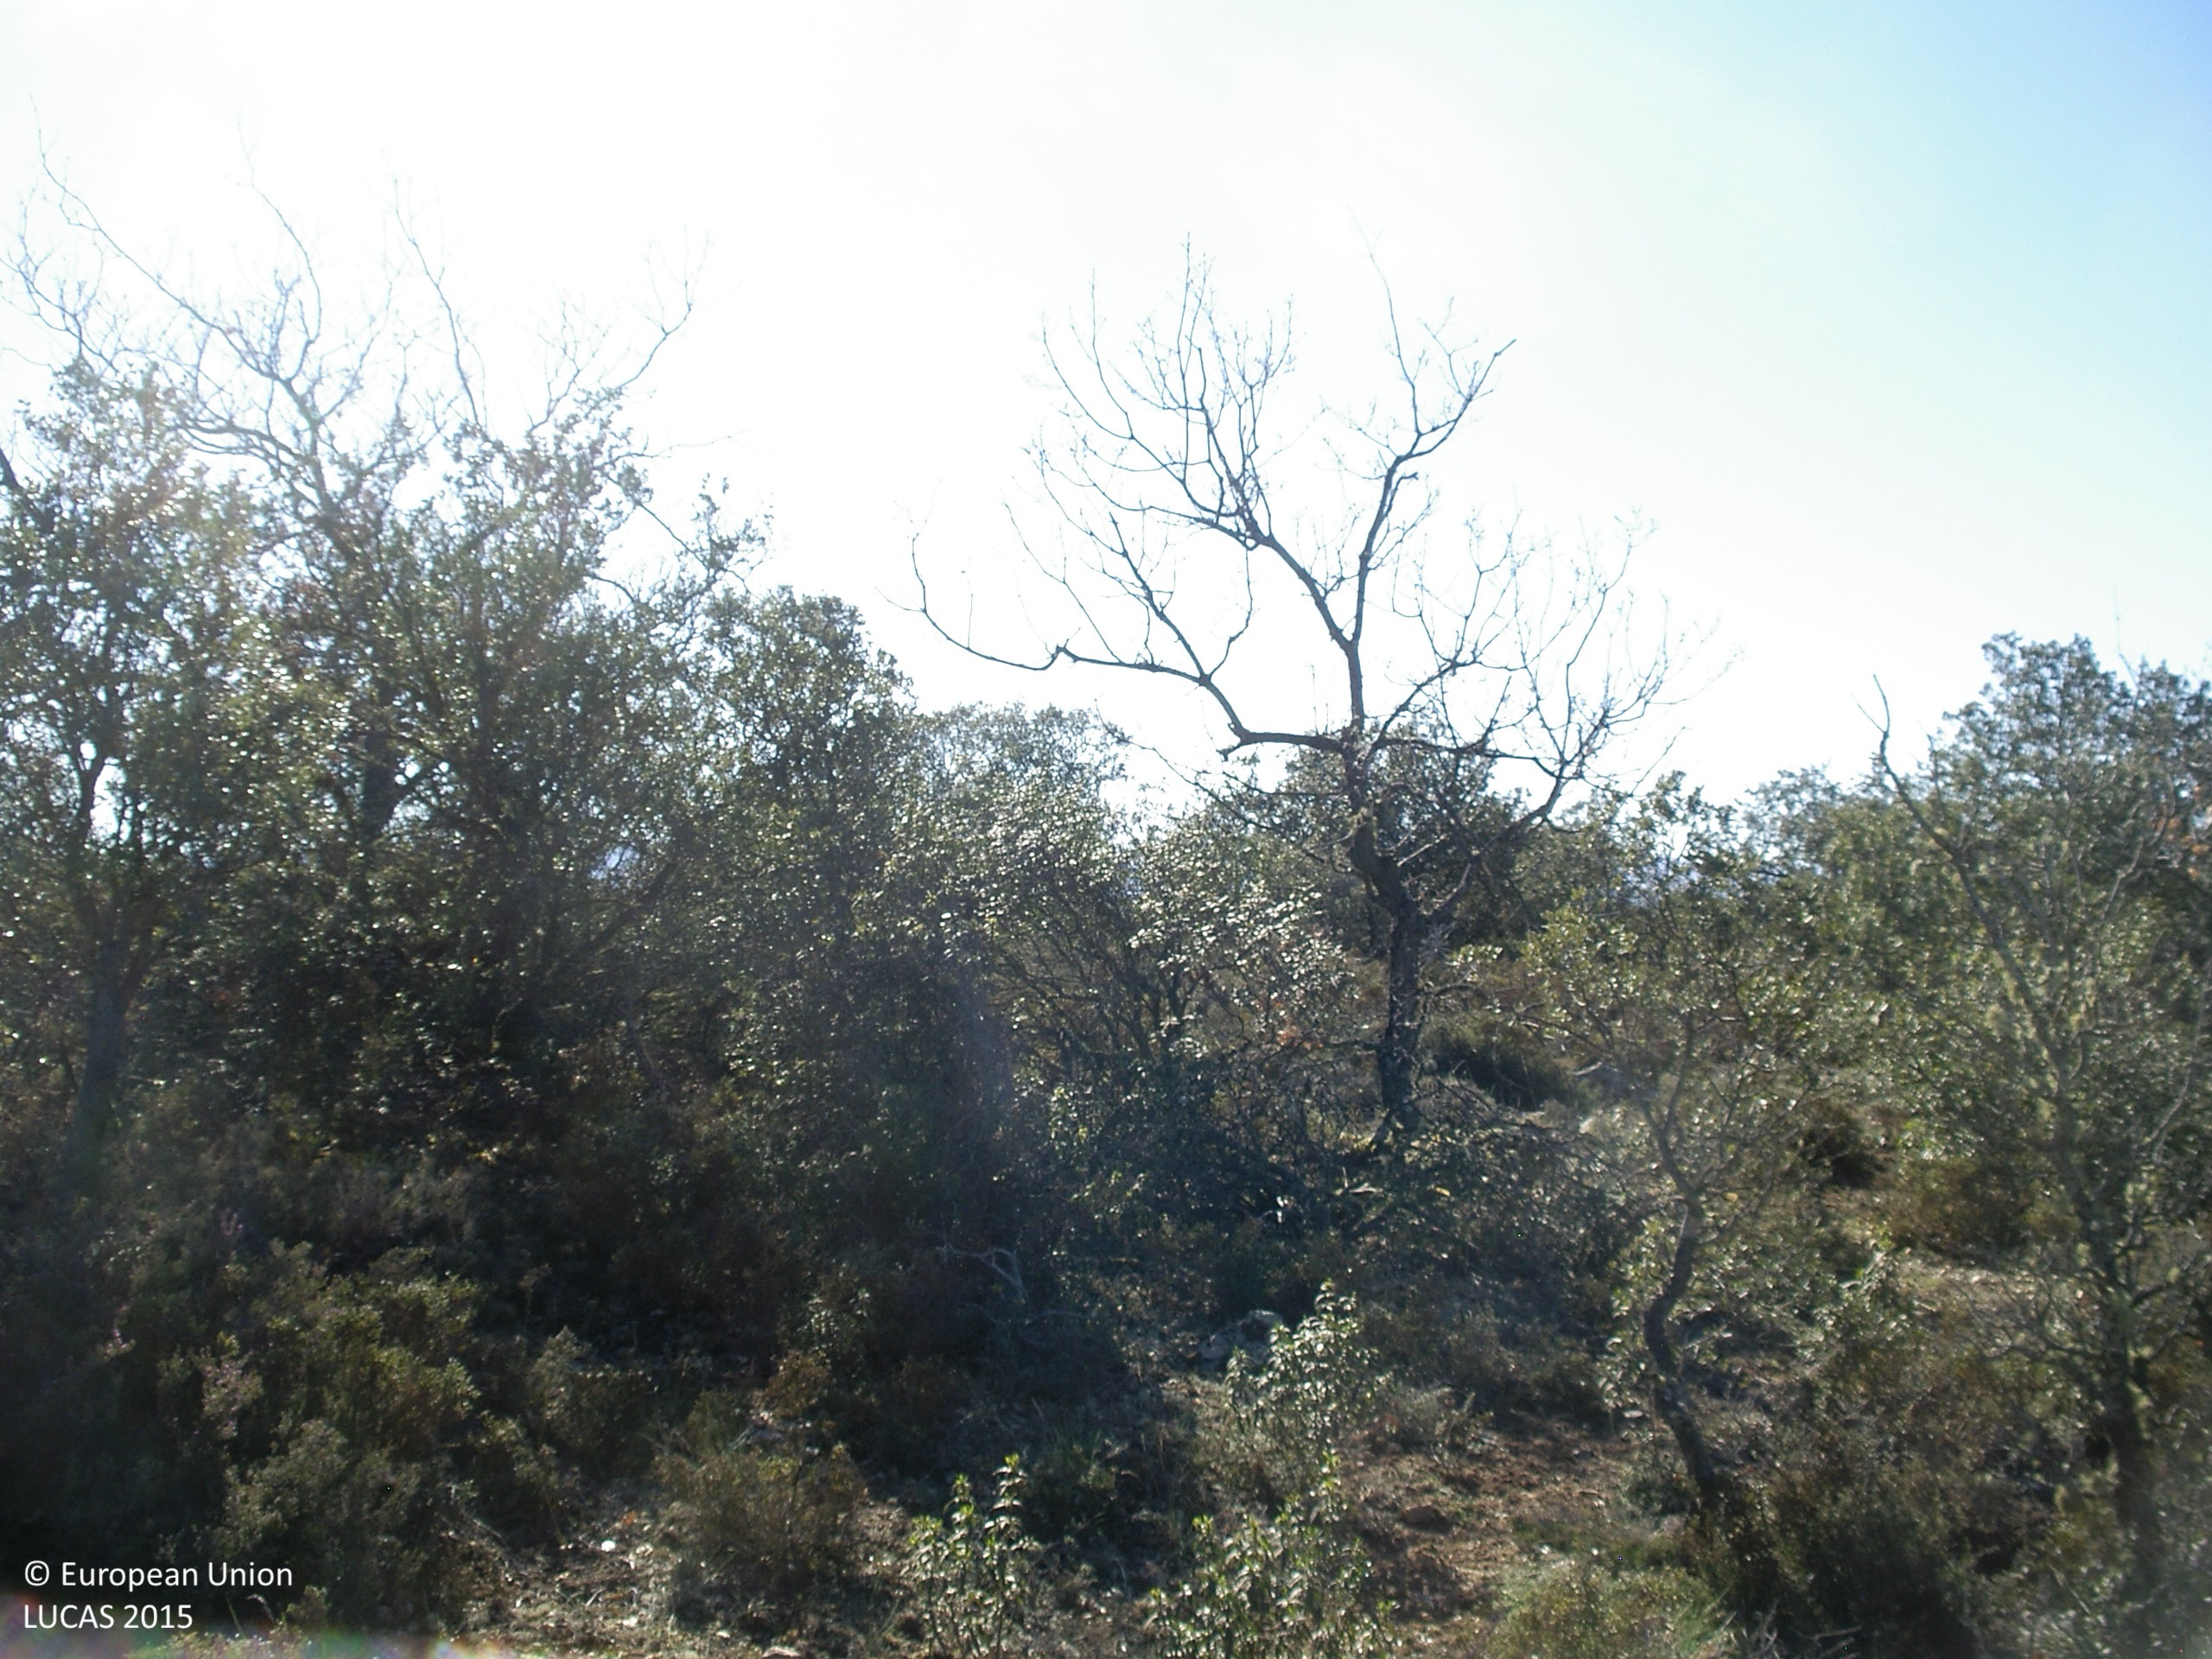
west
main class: Woodland
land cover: Broadleaved woodland
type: broadleaved evergreen forest
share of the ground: > 75 %
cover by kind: broadleaved forest trees 90 %, shrubs 10 %
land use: Forestry
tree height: > 5 m
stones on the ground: 10 - 25 %
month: March
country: ES
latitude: 42.3398
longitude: -6.0406
